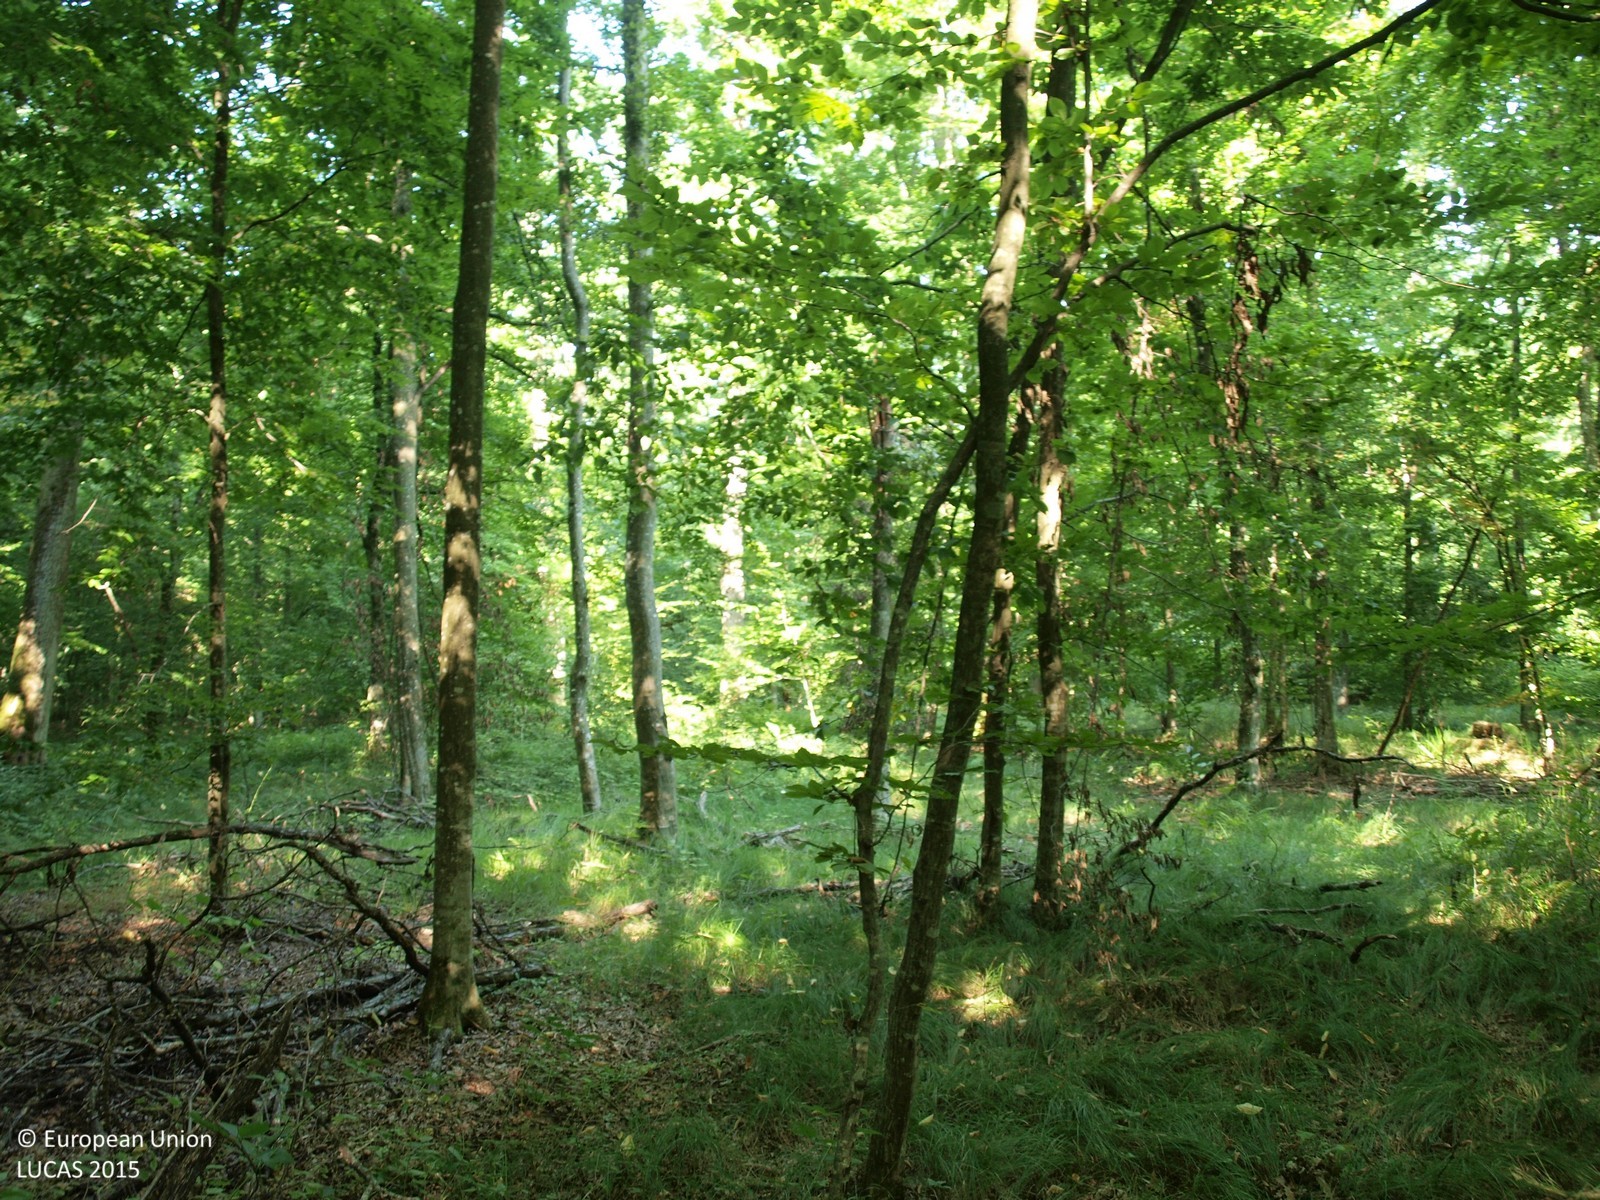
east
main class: Woodland
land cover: Broadleaved woodland
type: mesophytic deciduous forest
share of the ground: > 75 %
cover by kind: broadleaved forest trees 100 %
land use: Forestry
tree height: > 5 m
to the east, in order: Broadleaved woodland; Grassland without tree/shrub cover; Ditches and canals; Paved roads, cycling and walking lanes; Ditches and canals; Grassland without tree/shrub cover; Broadleaved woodland; Maize
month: August
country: HR
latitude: 45.8904
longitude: 16.6624
